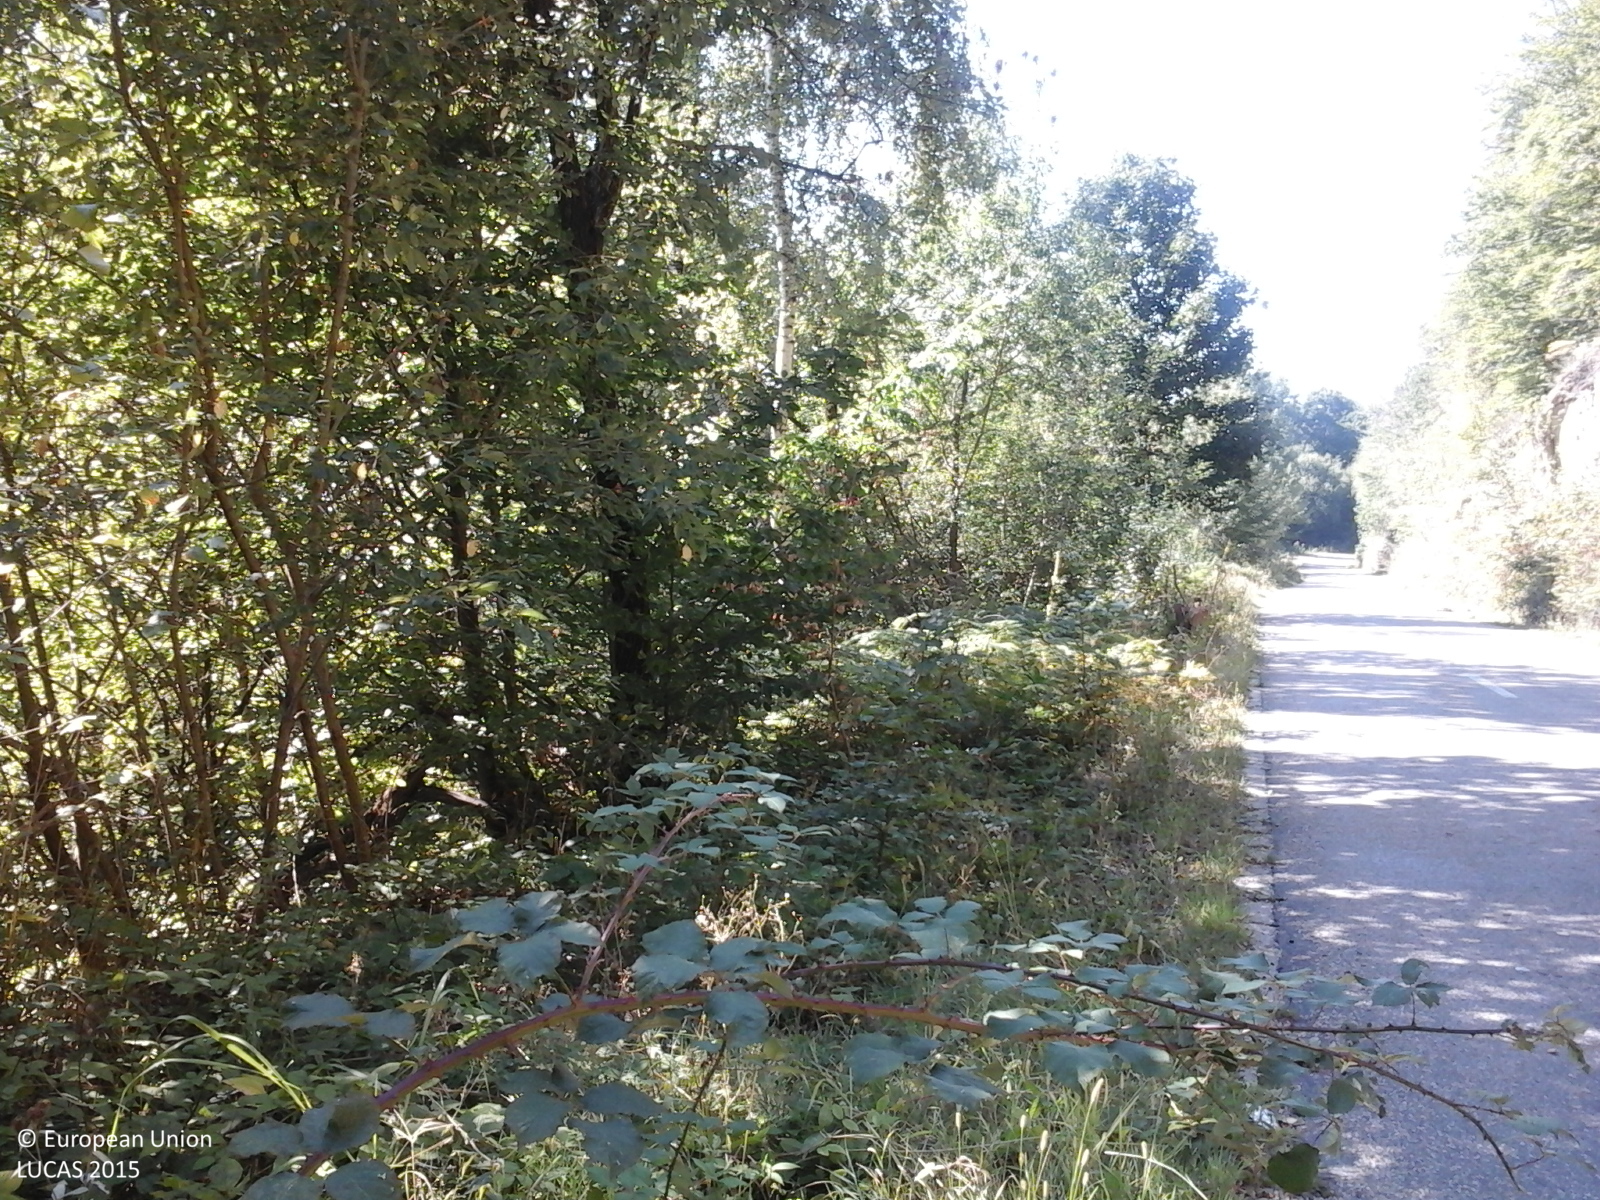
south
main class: Woodland
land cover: Broadleaved woodland
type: beech forest
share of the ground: > 75 %
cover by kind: broadleaved forest trees 100 %
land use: Forestry
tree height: > 5 m
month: September
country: RO
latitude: 46.6817
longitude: 22.5651
